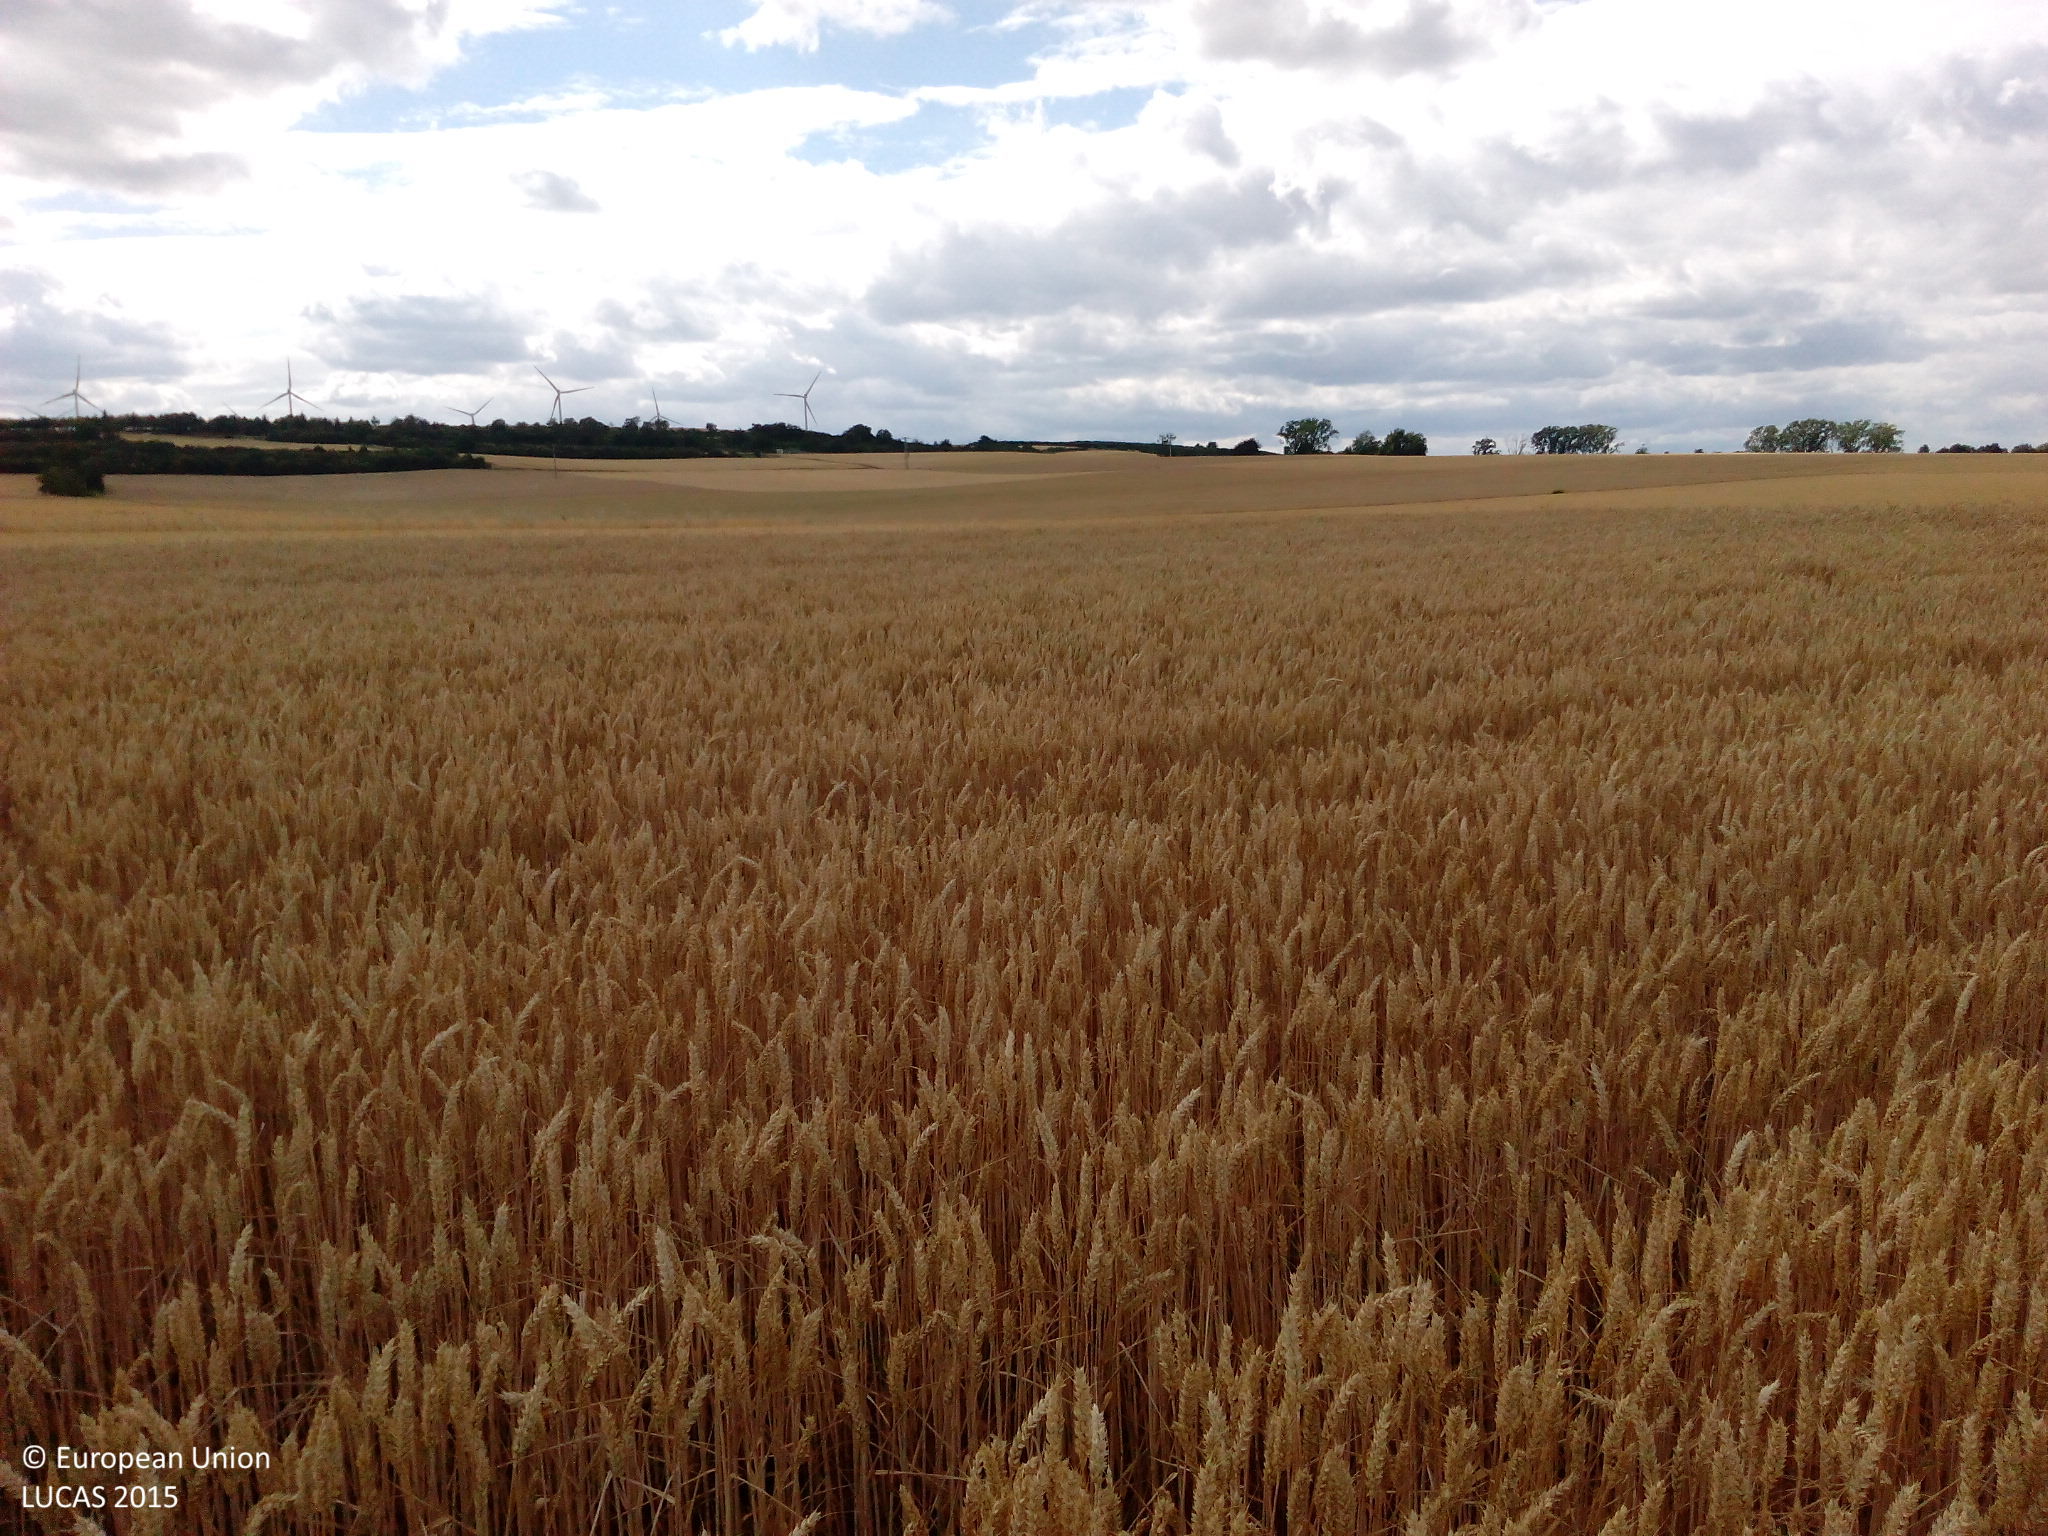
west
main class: Cropland
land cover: Common wheat
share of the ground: > 75 %
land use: Agriculture (excluding fallow land and kitchen gardens)
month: July
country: DE
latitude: 49.7017
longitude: 8.1564
